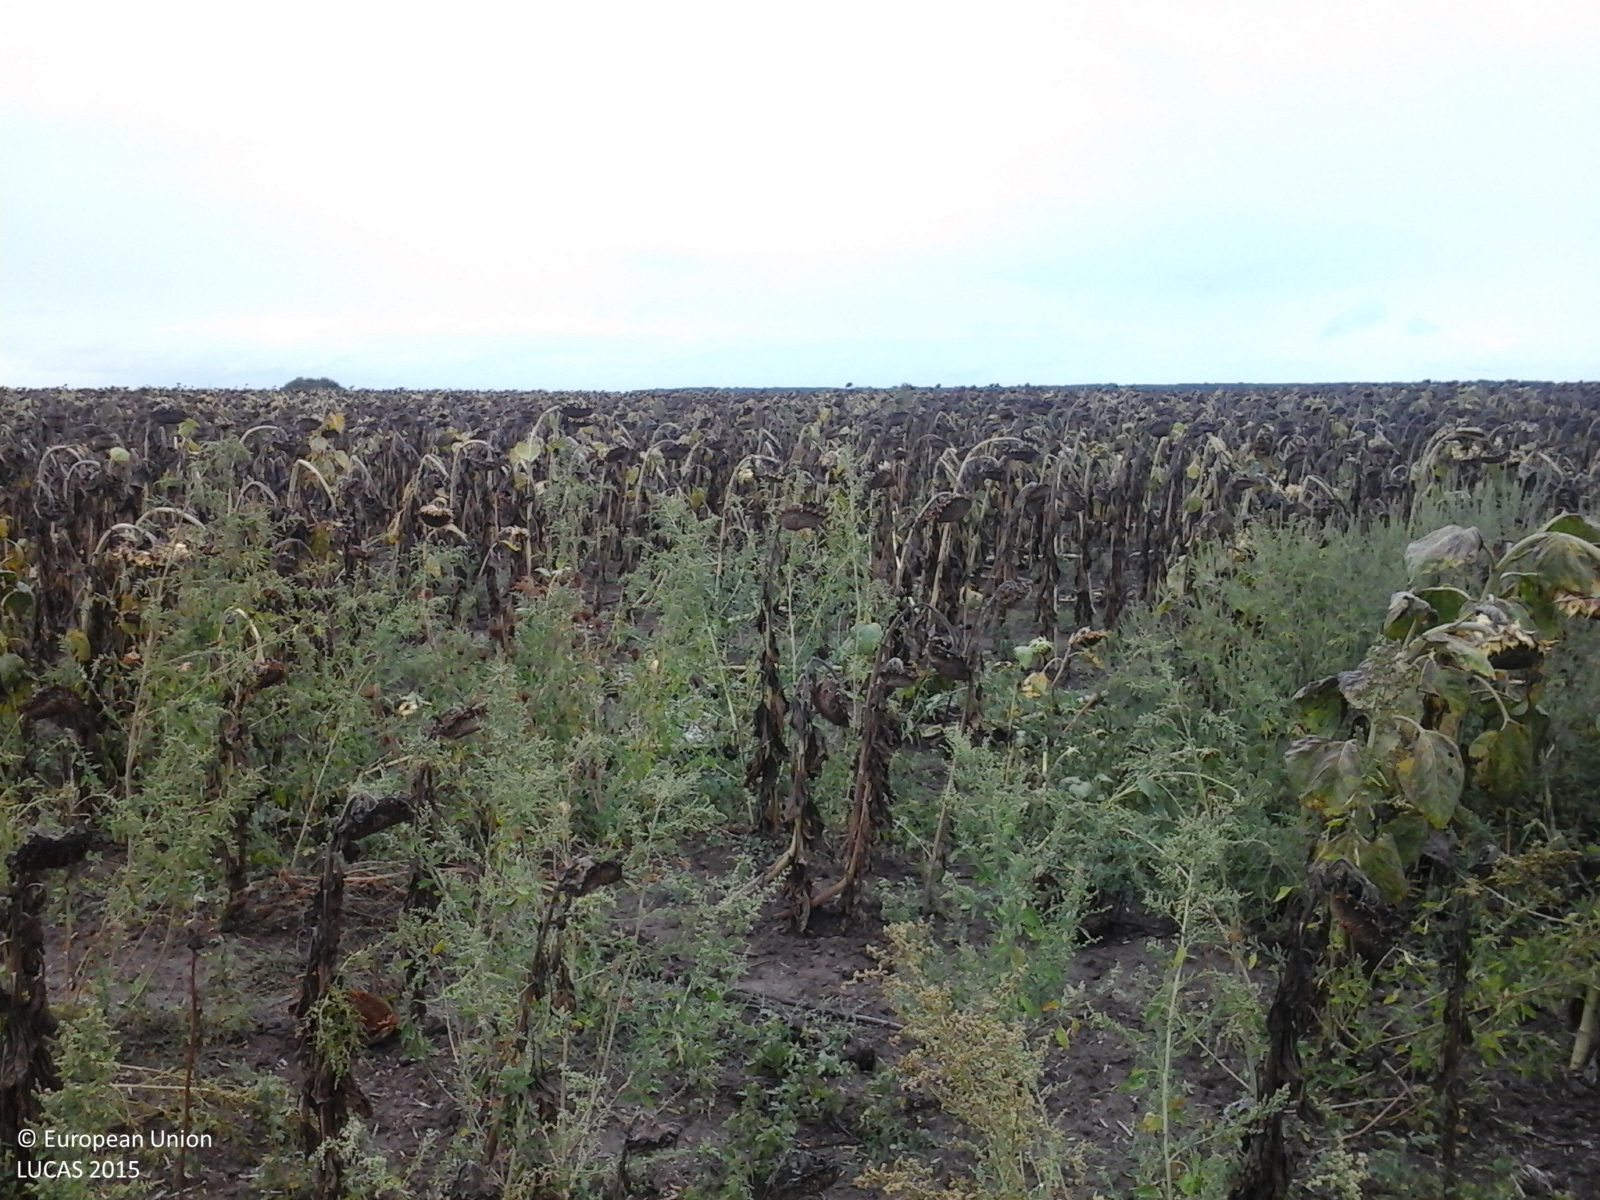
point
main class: Cropland
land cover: Sunflower
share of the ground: > 75 %
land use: Agriculture (excluding fallow land and kitchen gardens)
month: September
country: RO
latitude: 46.8353
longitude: 21.8572
